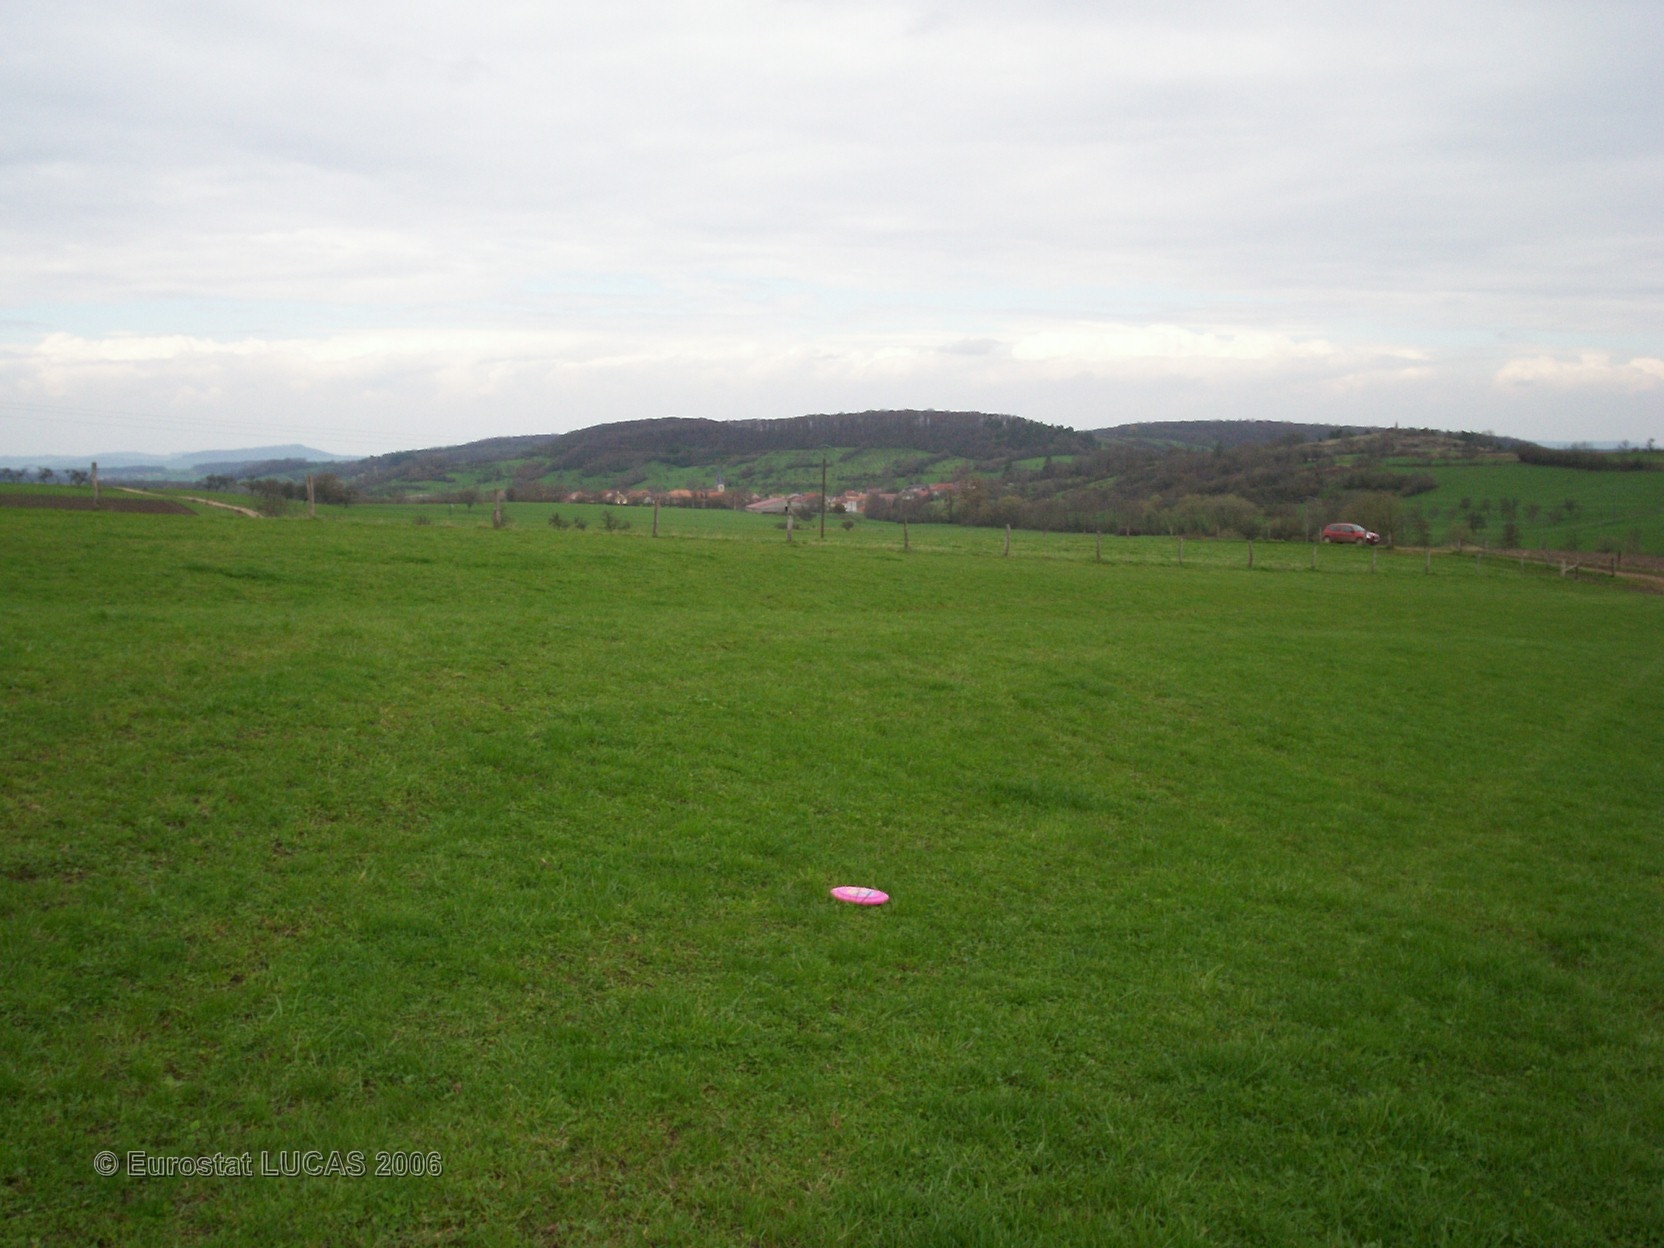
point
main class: Grassland
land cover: Grassland without tree/shrub cover
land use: Agriculture (excluding fallow land and kitchen gardens)
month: April
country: FR
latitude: 48.2411
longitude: 6.0011
